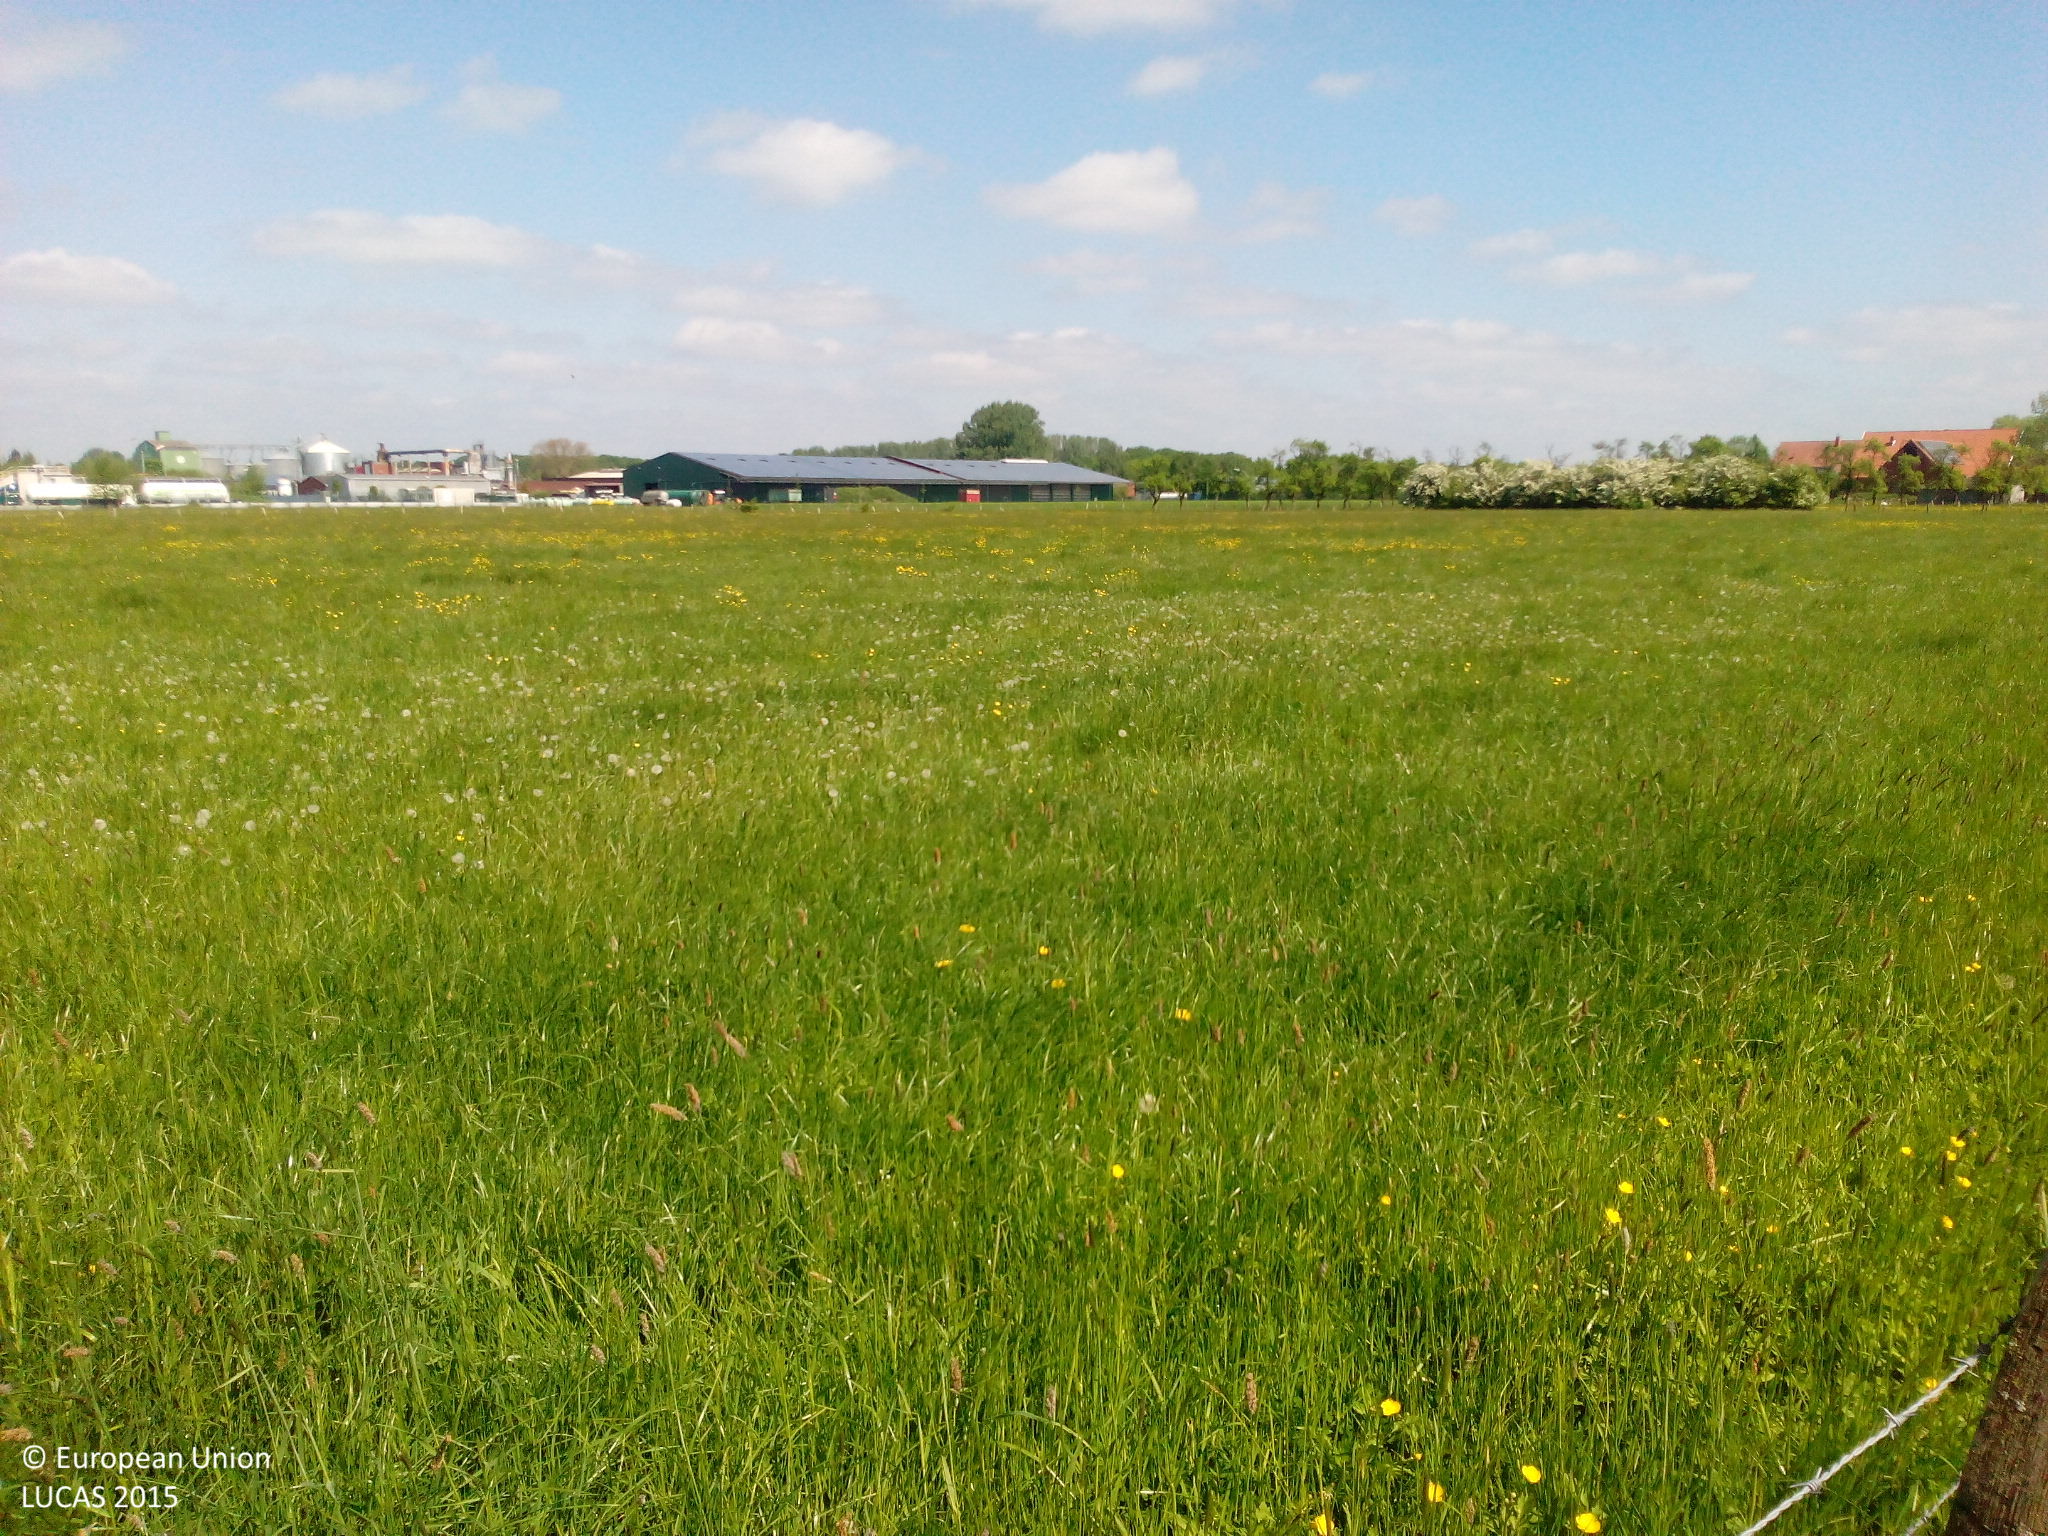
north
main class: Grassland
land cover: Grassland without tree/shrub cover
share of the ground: > 75 %
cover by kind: herbaceous plants 100 %
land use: Agriculture (excluding fallow land and kitchen gardens)
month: May
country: DE
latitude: 51.9108
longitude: 7.9798
